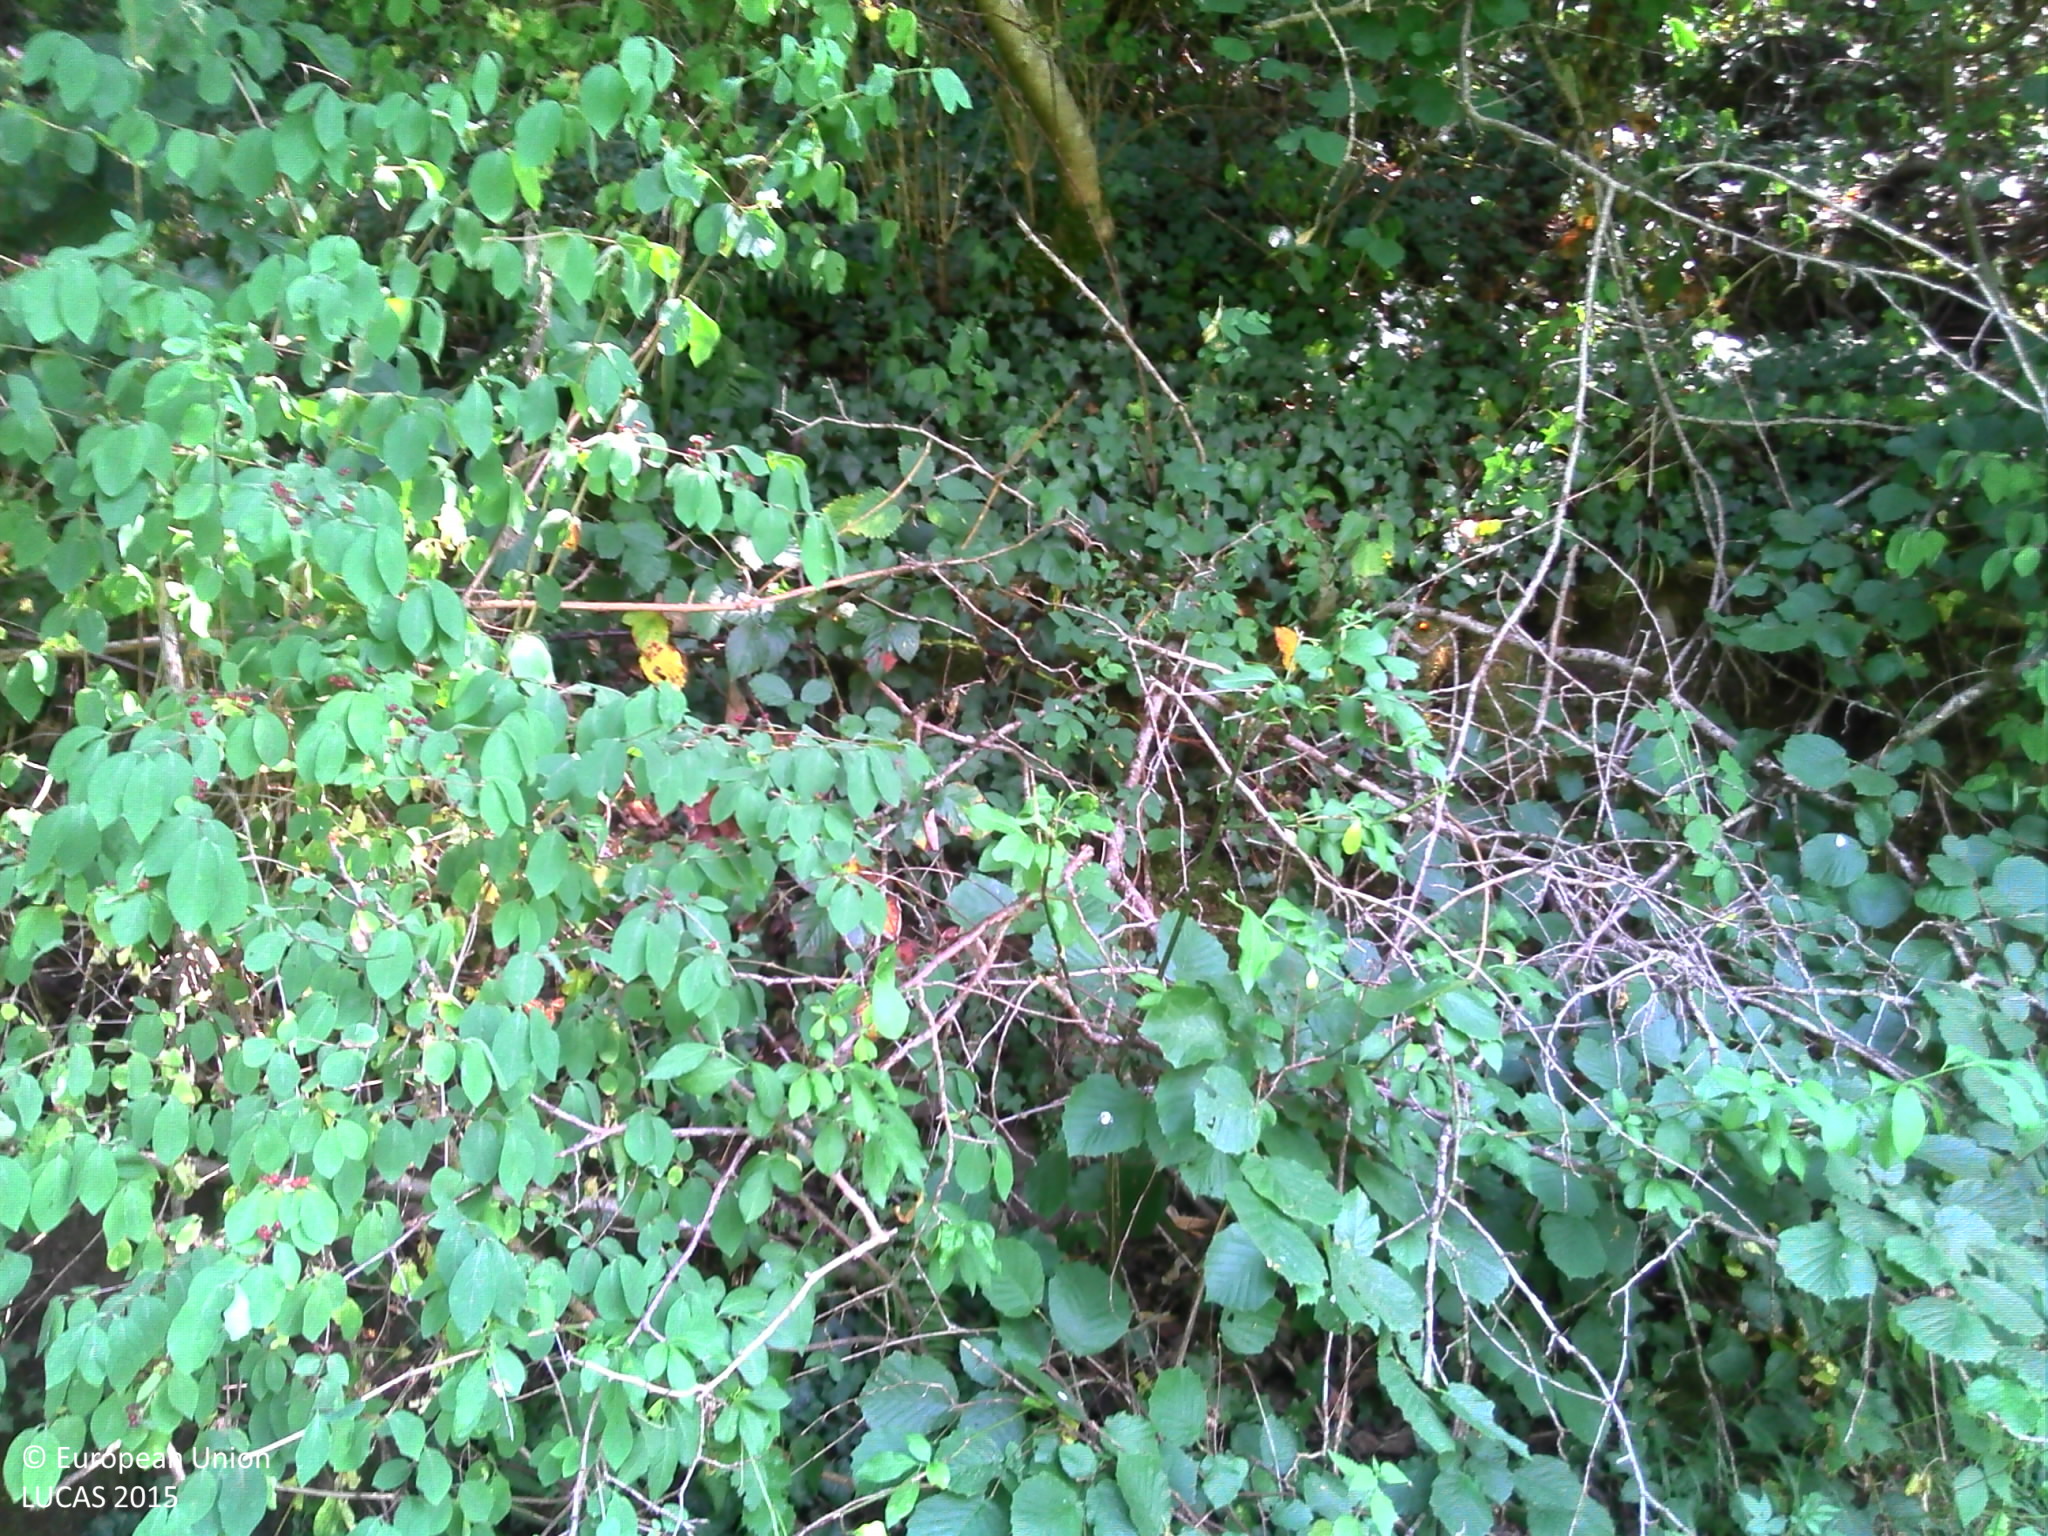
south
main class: Woodland
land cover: Broadleaved woodland
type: mesophytic deciduous forest
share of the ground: > 75 %
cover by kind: broadleaved forest trees 100 %
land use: Forestry
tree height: > 5 m
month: July
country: FR
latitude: 45.2855
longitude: 3.2063
